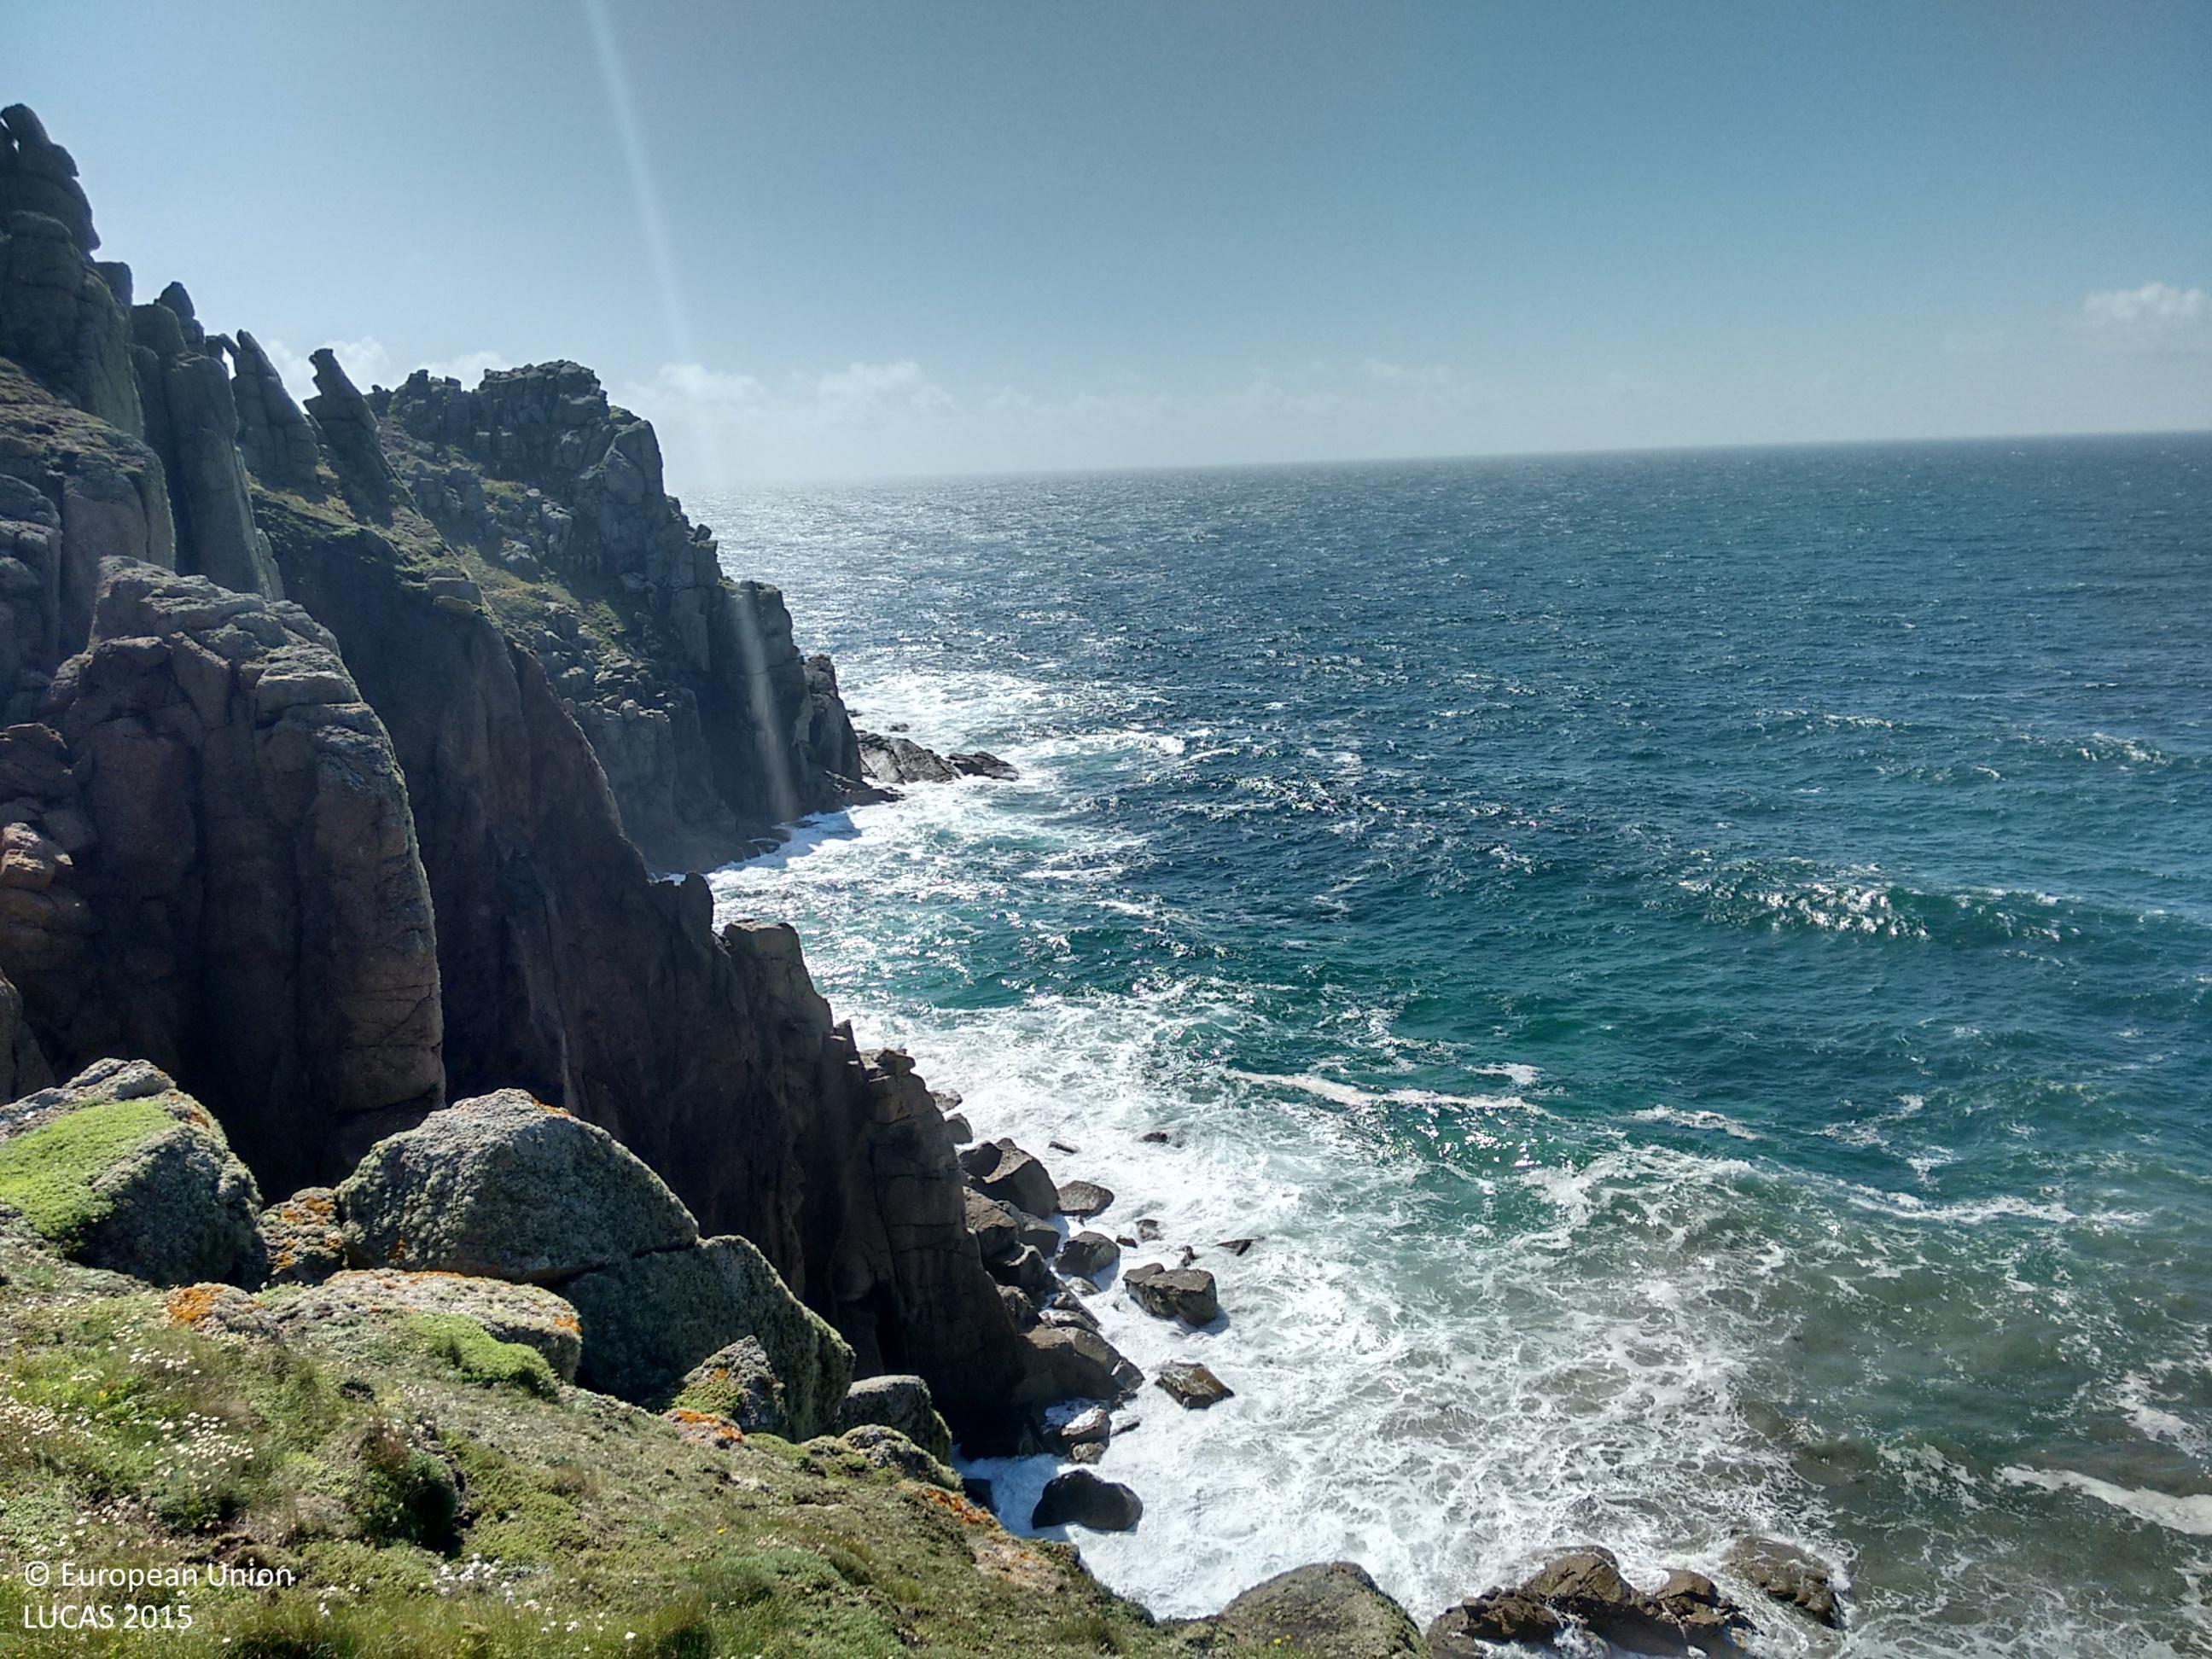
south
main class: Grassland
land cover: Grassland without tree/shrub cover
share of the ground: > 75 %
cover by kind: herbaceous plants 90 %, unconsolidated bare surface 10 %
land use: Agriculture (excluding fallow land and kitchen gardens)
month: August
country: GB
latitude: 50.0577
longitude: -5.7069
